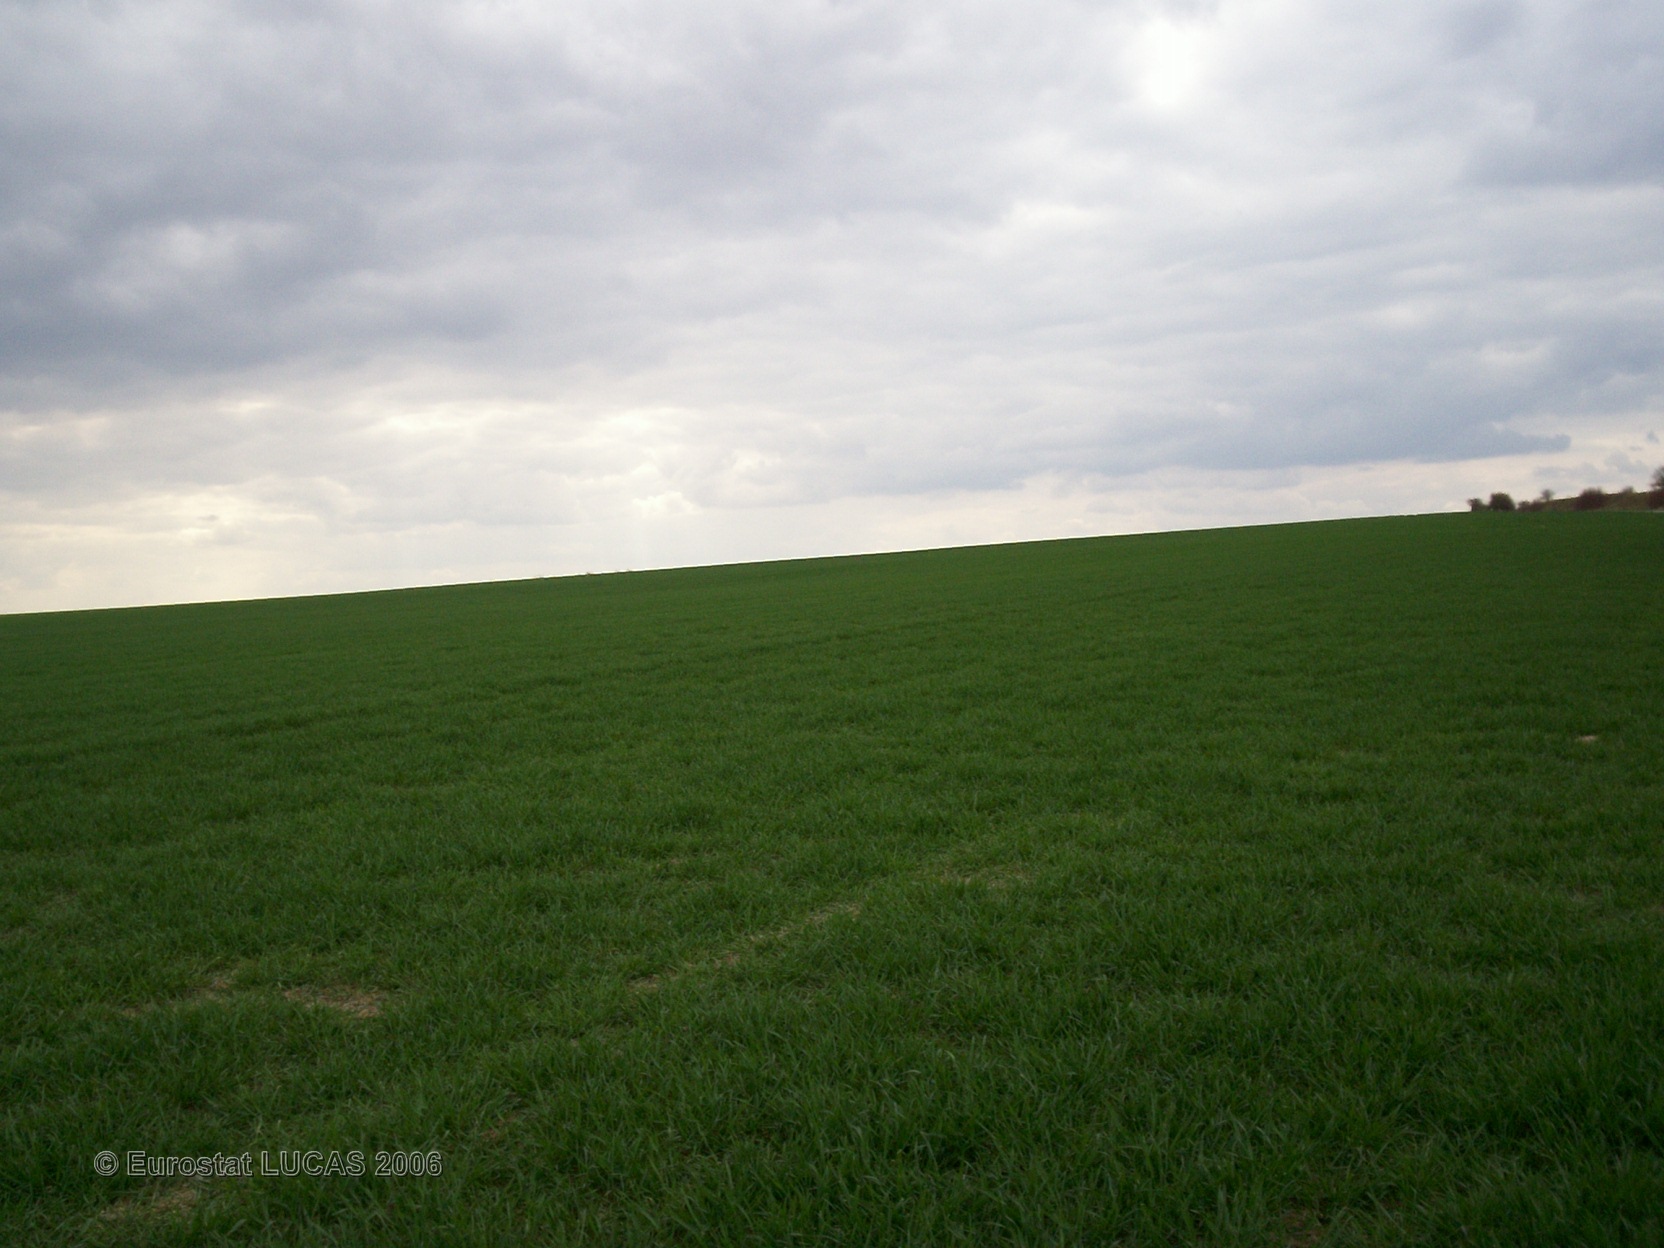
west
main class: Cropland
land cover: Common wheat
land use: Agriculture (excluding fallow land and kitchen gardens)
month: April
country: FR
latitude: 49.2357
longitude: 4.4065
